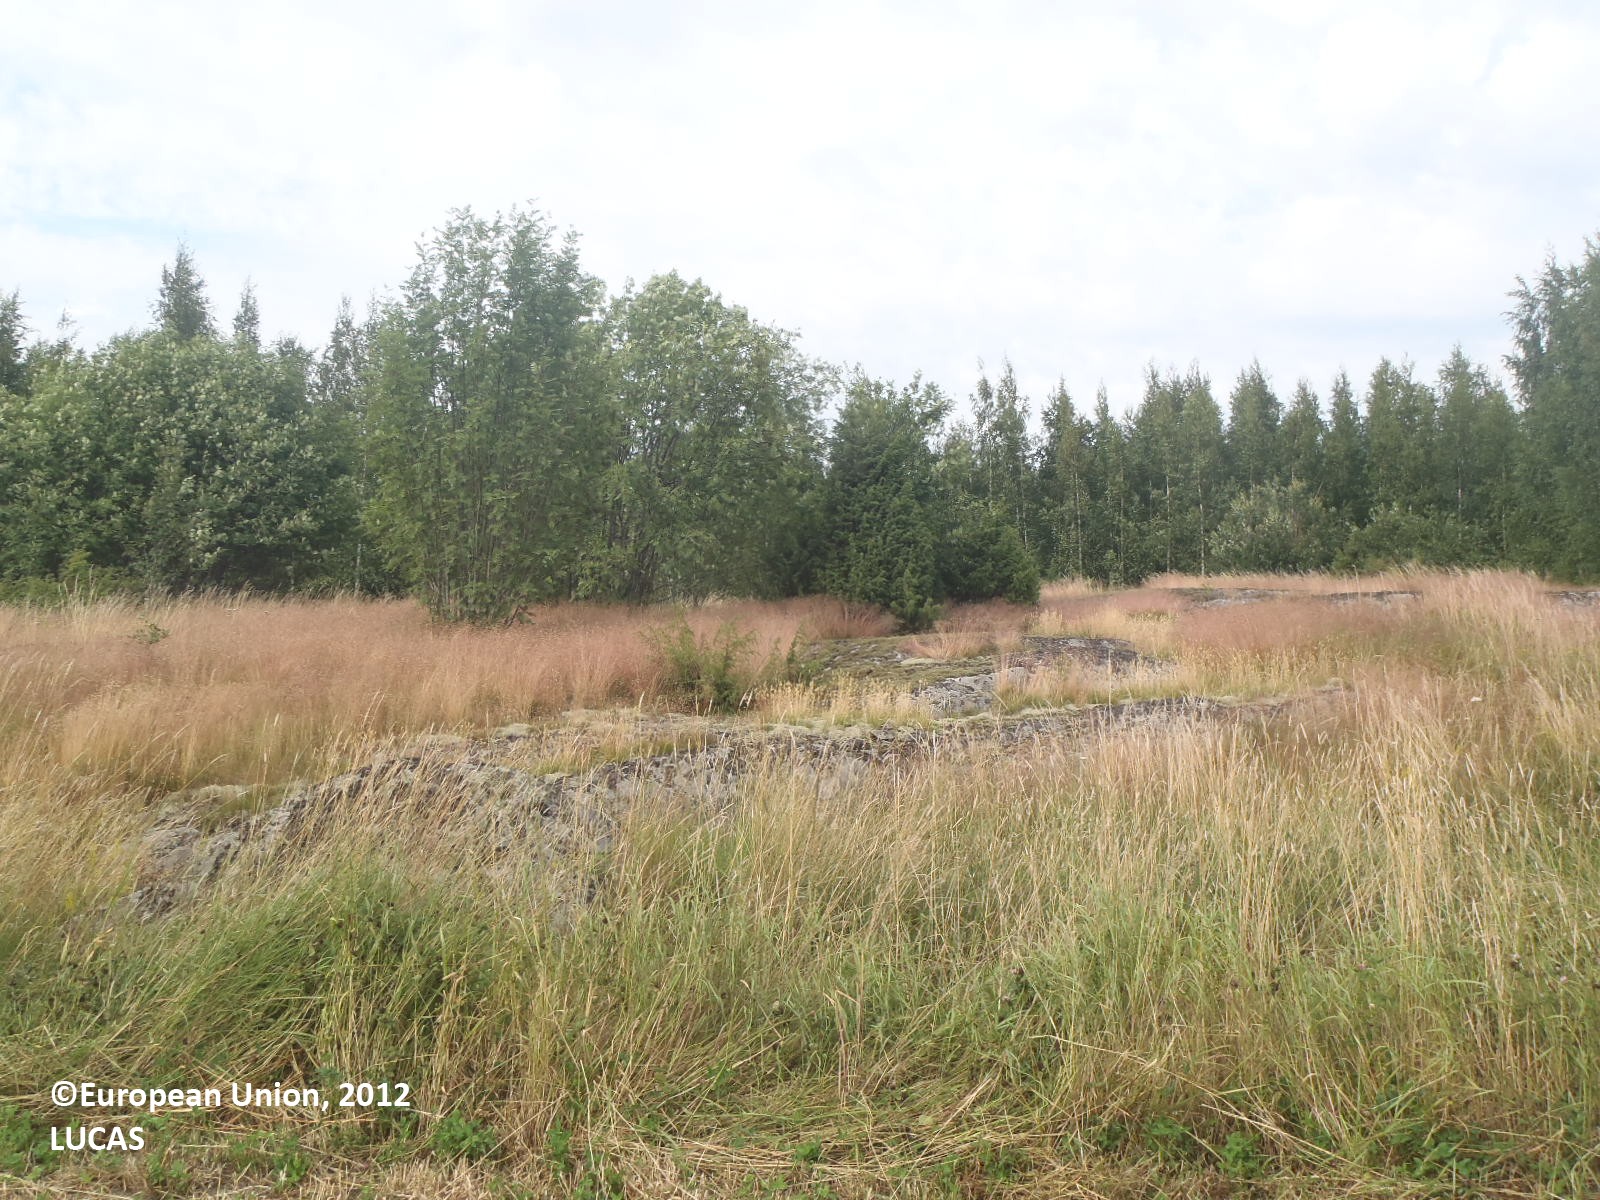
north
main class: Cropland
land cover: Temporary grasslands
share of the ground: > 75 %
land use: Agriculture (excluding fallow land and kitchen gardens)
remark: Harvested field
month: July
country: FI
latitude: 60.3646
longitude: 21.9383
